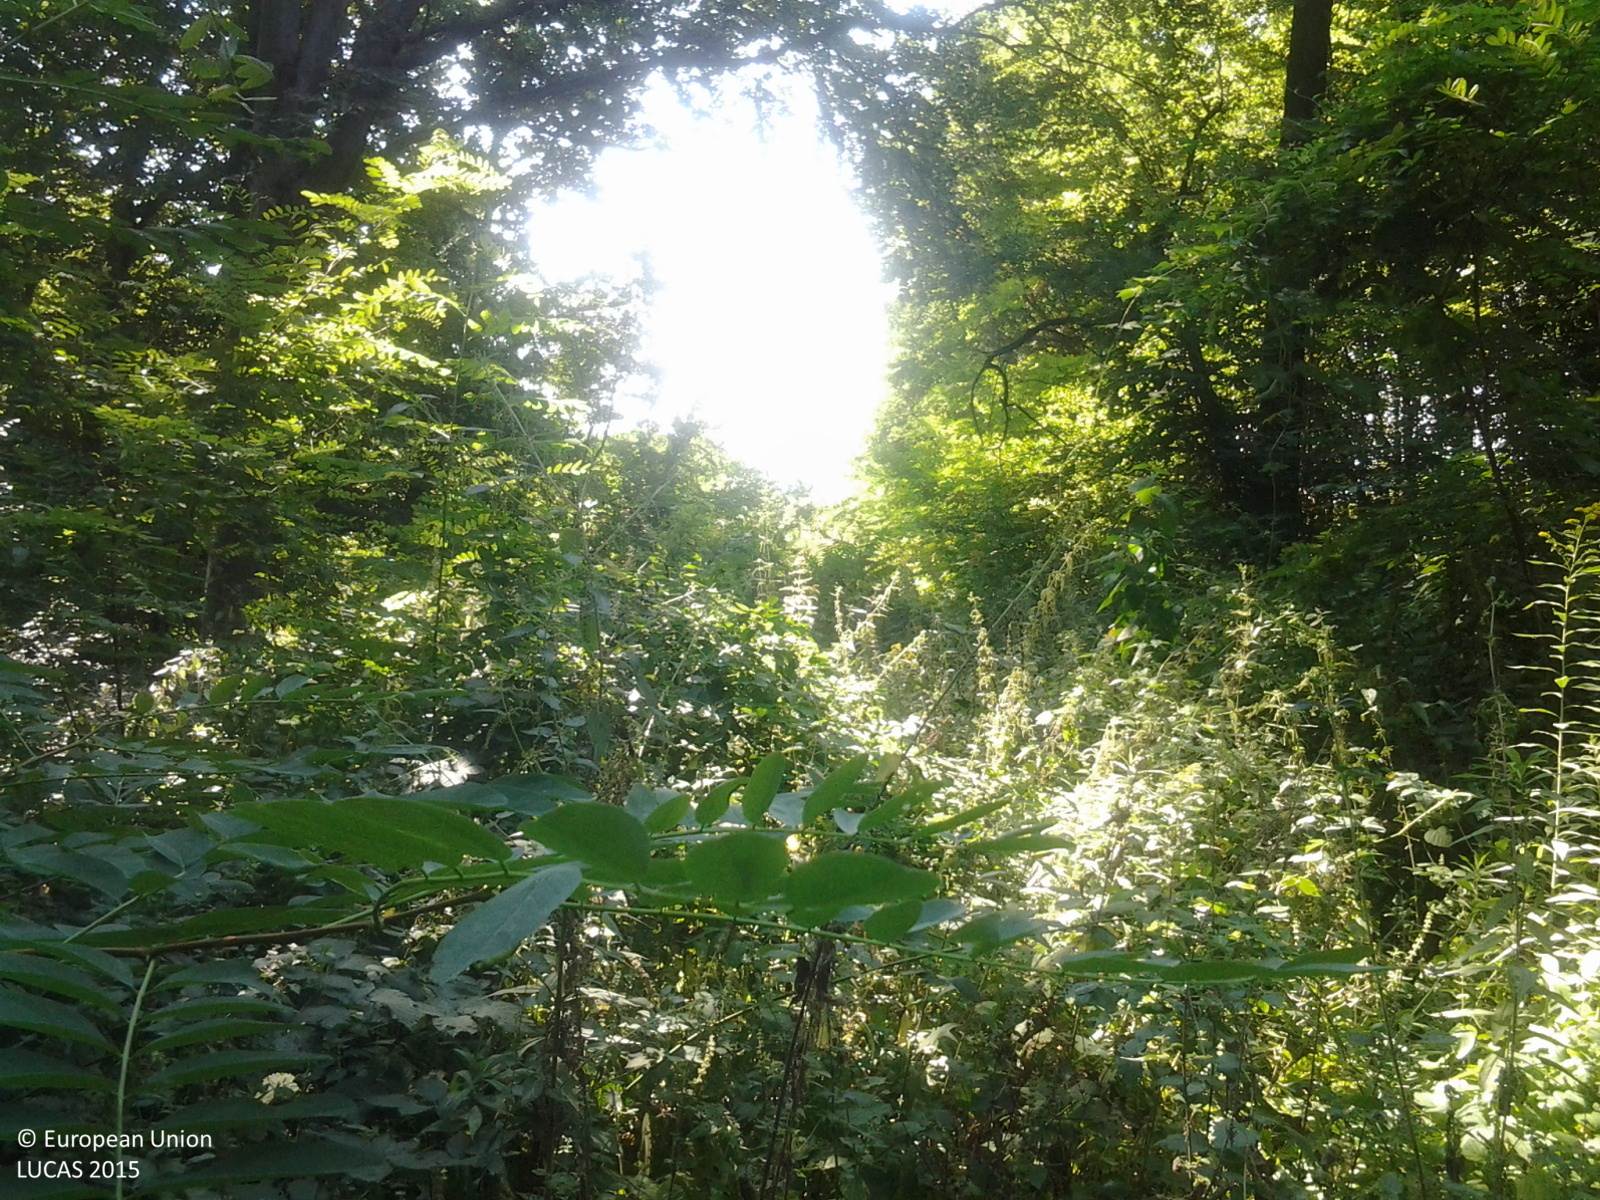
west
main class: Woodland
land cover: Broadleaved woodland
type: beech forest
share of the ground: > 75 %
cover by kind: broadleaved forest trees 90 %, herbaceous plants 10 %
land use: Forestry
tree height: > 5 m
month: August
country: HU
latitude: 46.5338
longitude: 17.0569
